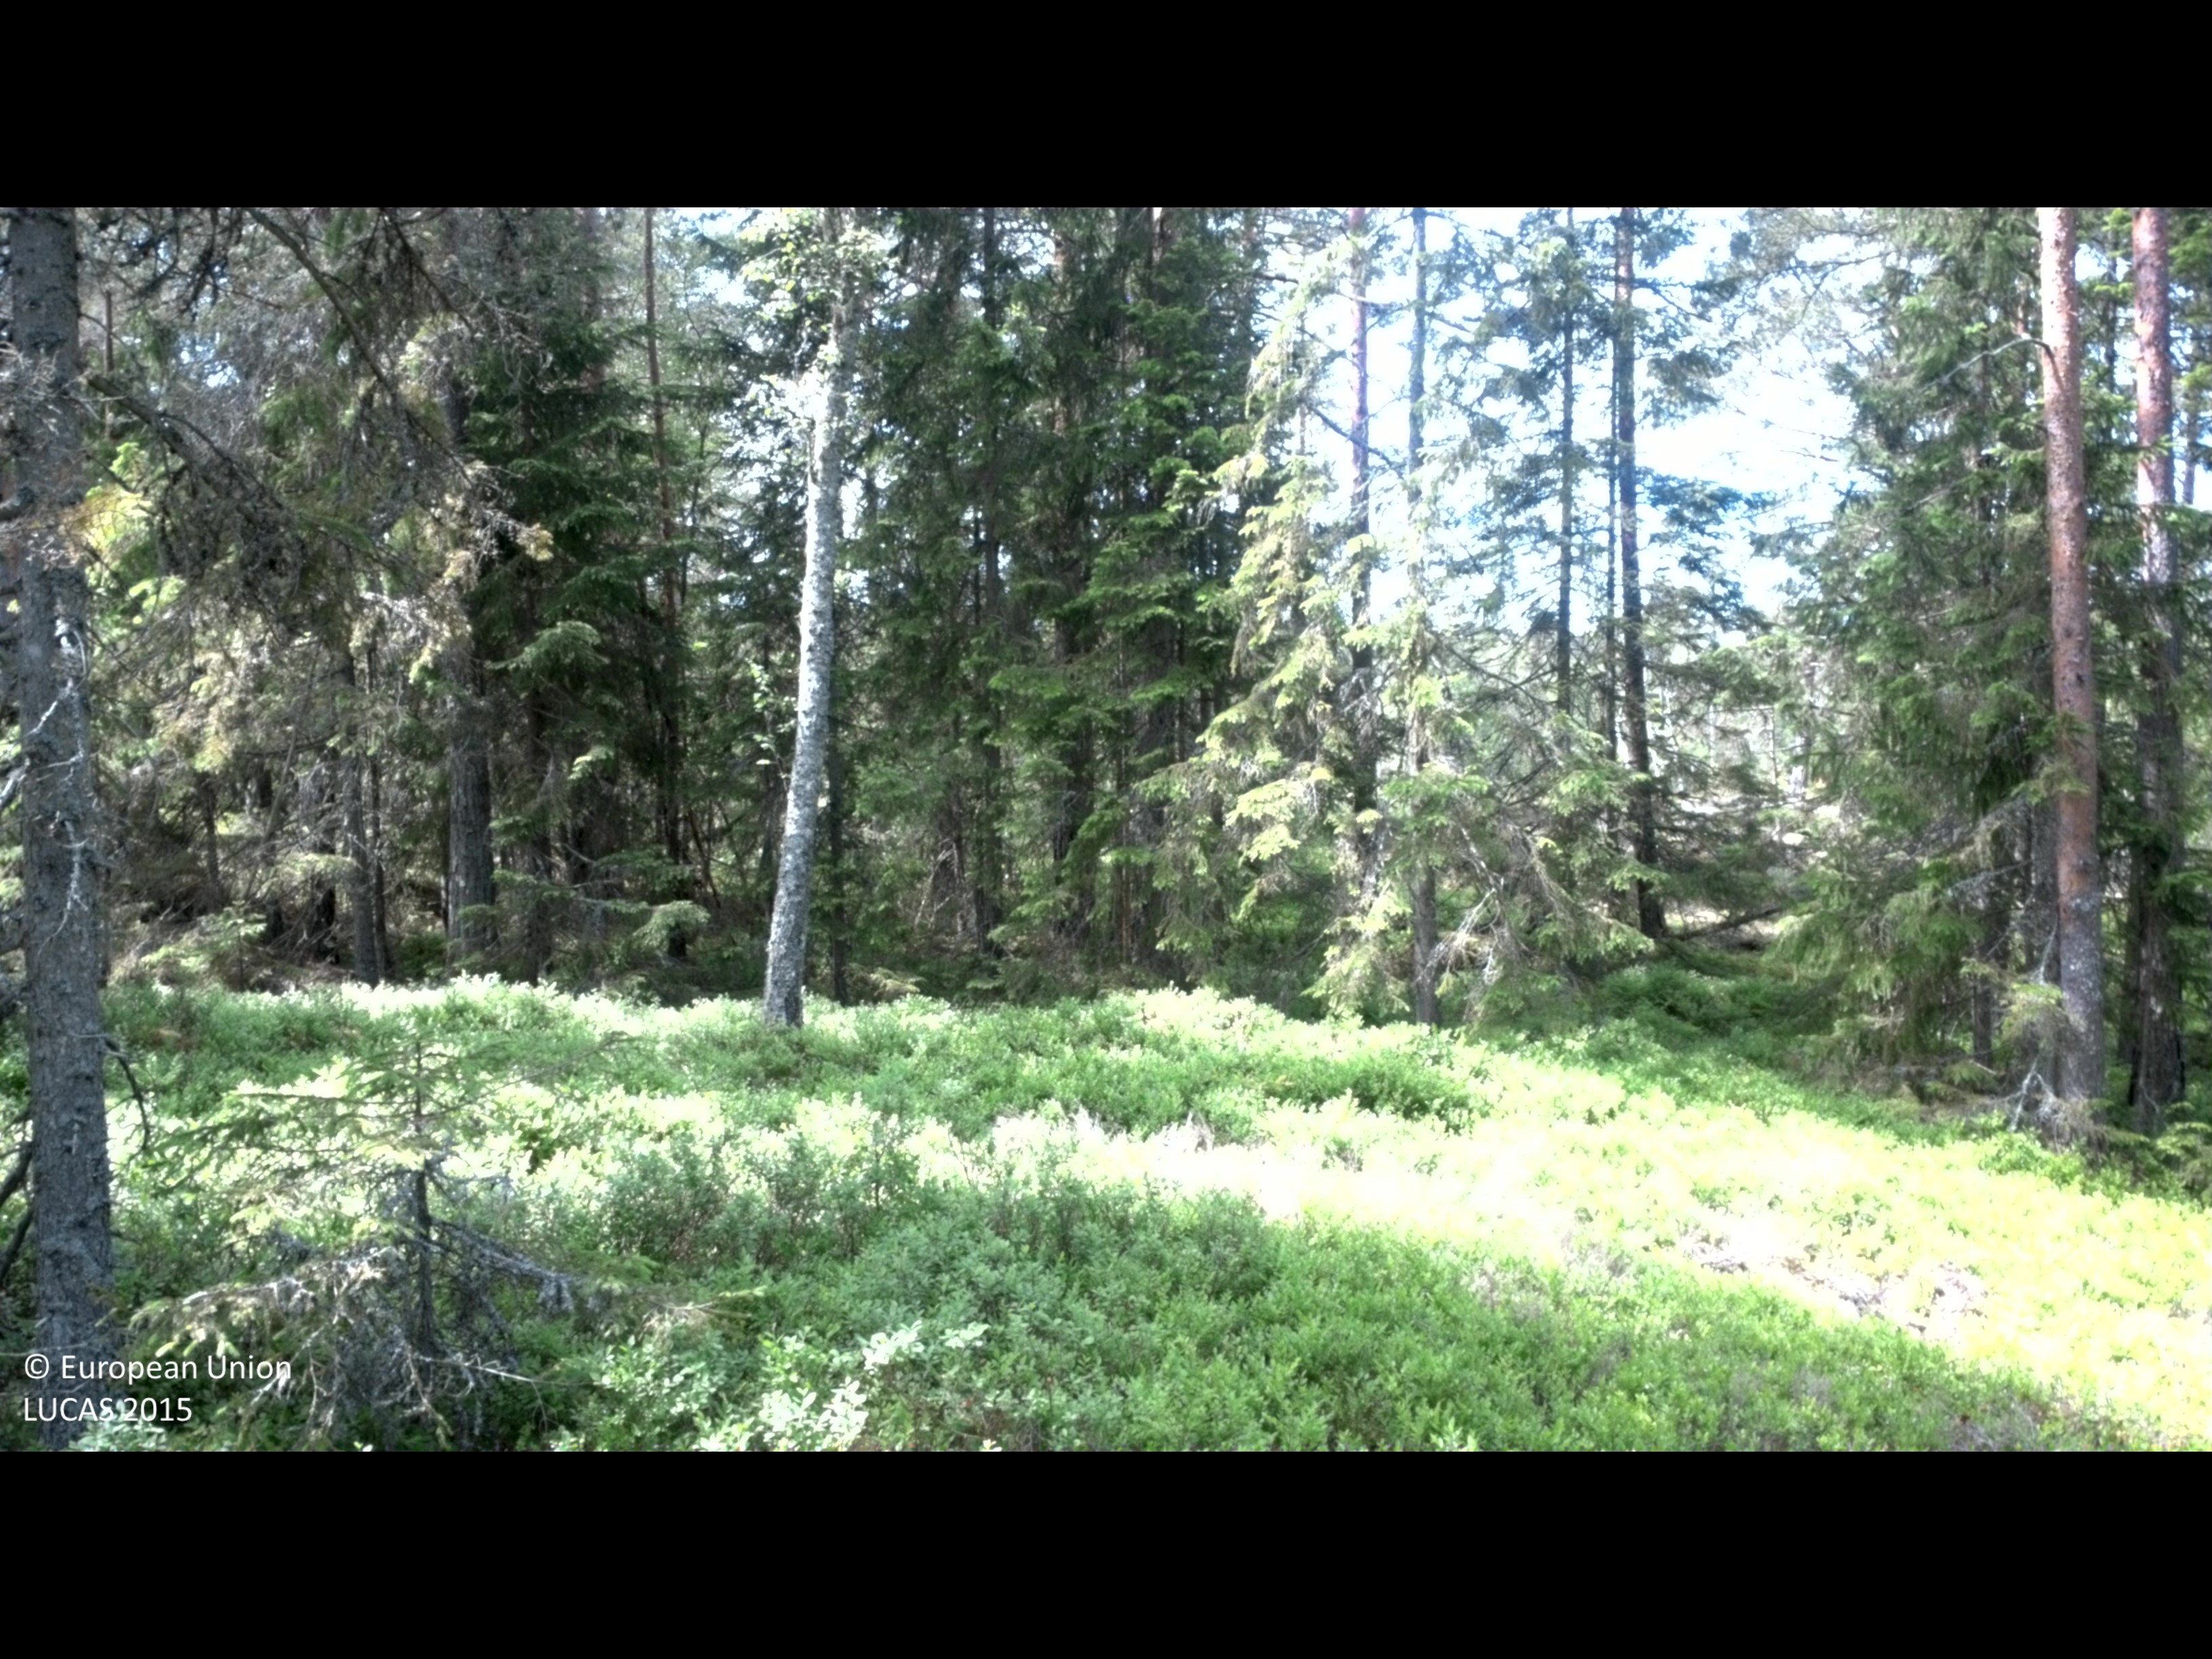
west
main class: Woodland
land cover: Other coniferous woodland
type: boreal forest
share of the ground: 50 - 75 %
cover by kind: coniferous forest trees 50 %, shrubs 30 %, lichens and mosses 15 %, broadleaved forest trees 5 %
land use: Forestry
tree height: > 5 m
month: June
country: SE
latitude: 57.6268
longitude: 16.5464
